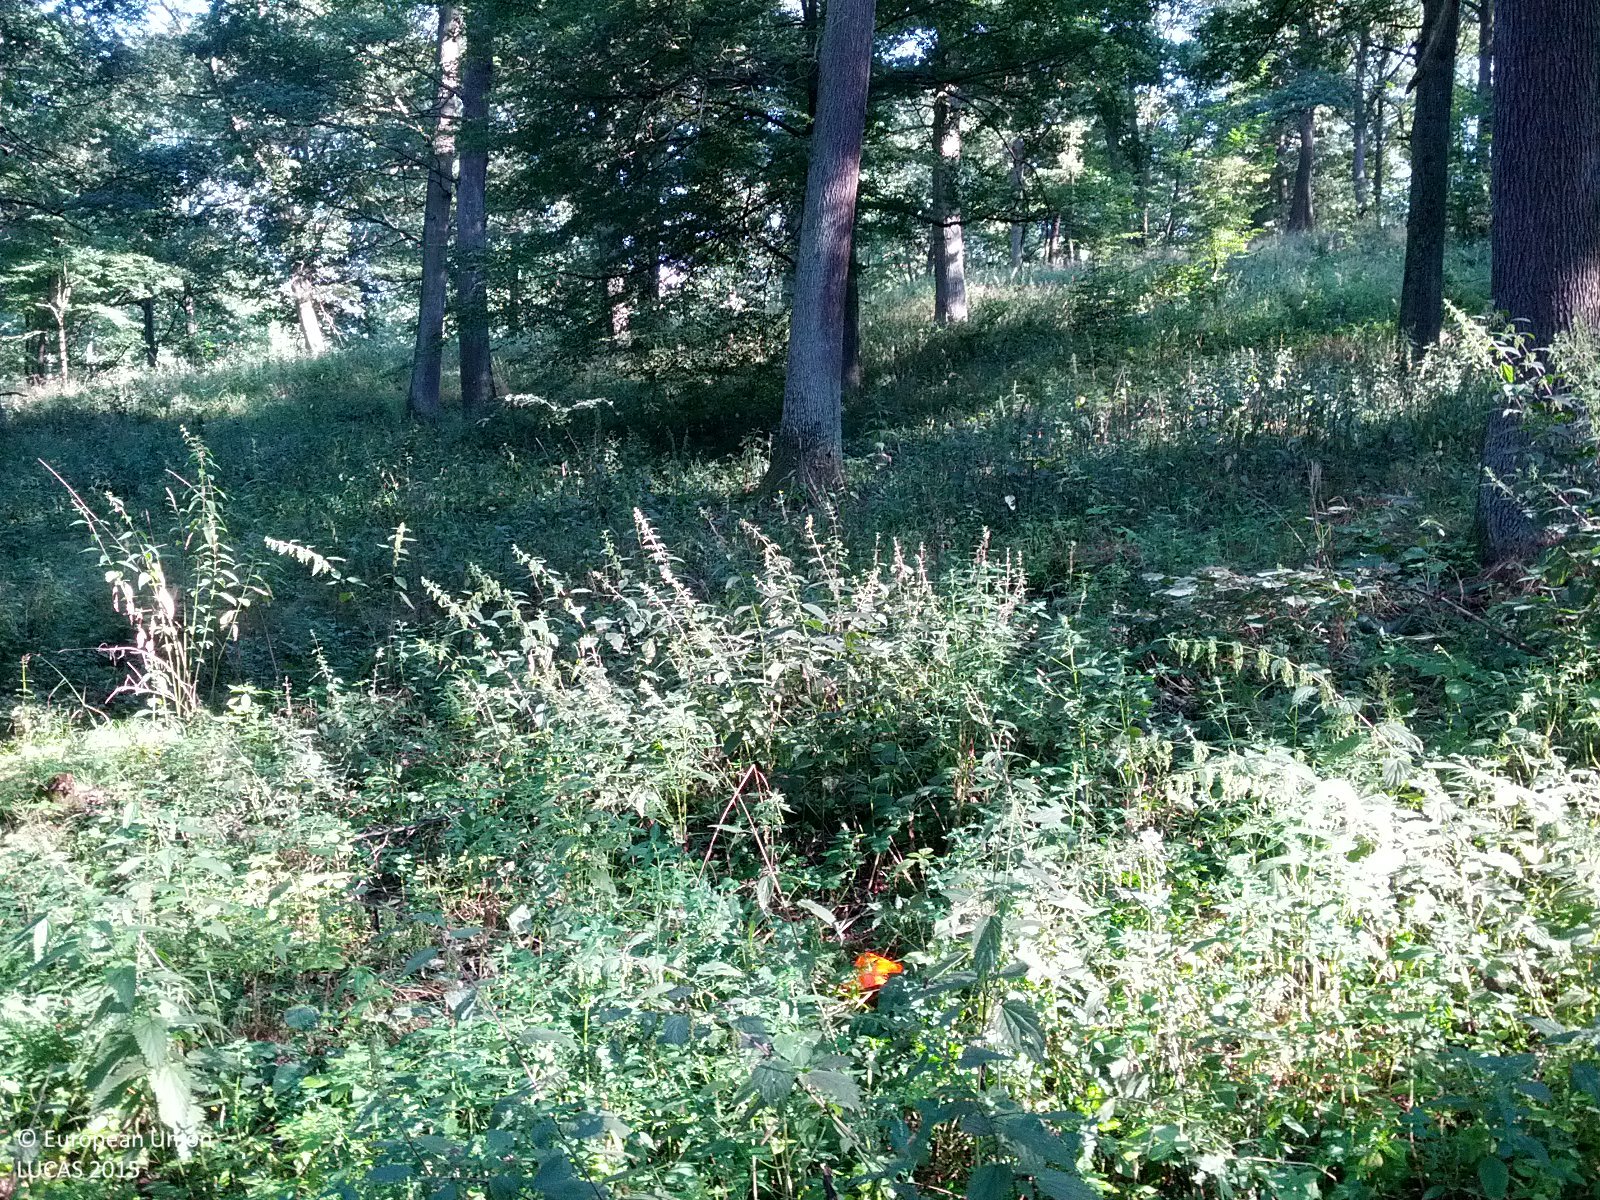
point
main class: Woodland
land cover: Broadleaved woodland
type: acidophilous oak and oak-birch forest
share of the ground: > 75 %
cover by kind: broadleaved forest trees 80 %, herbaceous plants 20 %
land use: Forestry
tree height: > 5 m
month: July
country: AT
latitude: 48.5499
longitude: 16.2775
